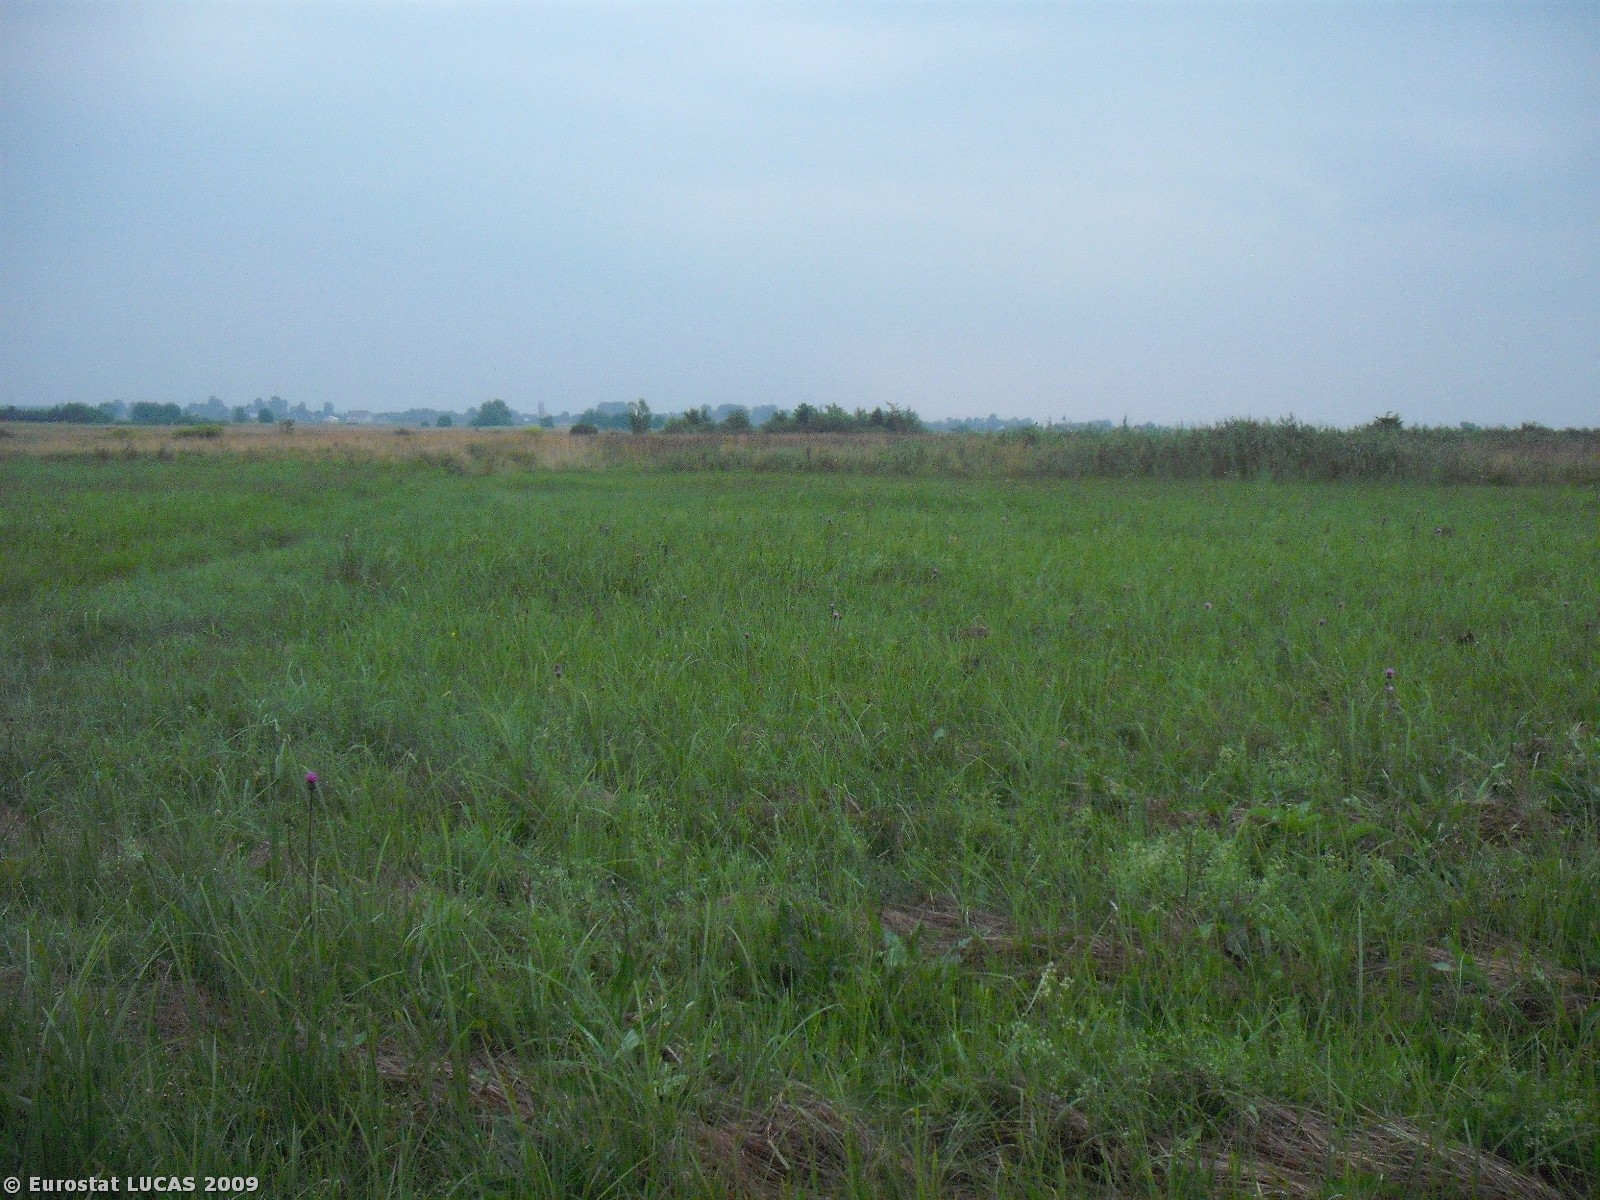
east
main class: Grassland
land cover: Grassland without tree/shrub cover
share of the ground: > 75 %
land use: Agriculture (excluding fallow land and kitchen gardens)
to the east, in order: Grassland without tree/shrub cover; Spontaneously vegetated surfaces; Grassland without tree/shrub cover
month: August
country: PL
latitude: 50.0799
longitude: 22.4599
